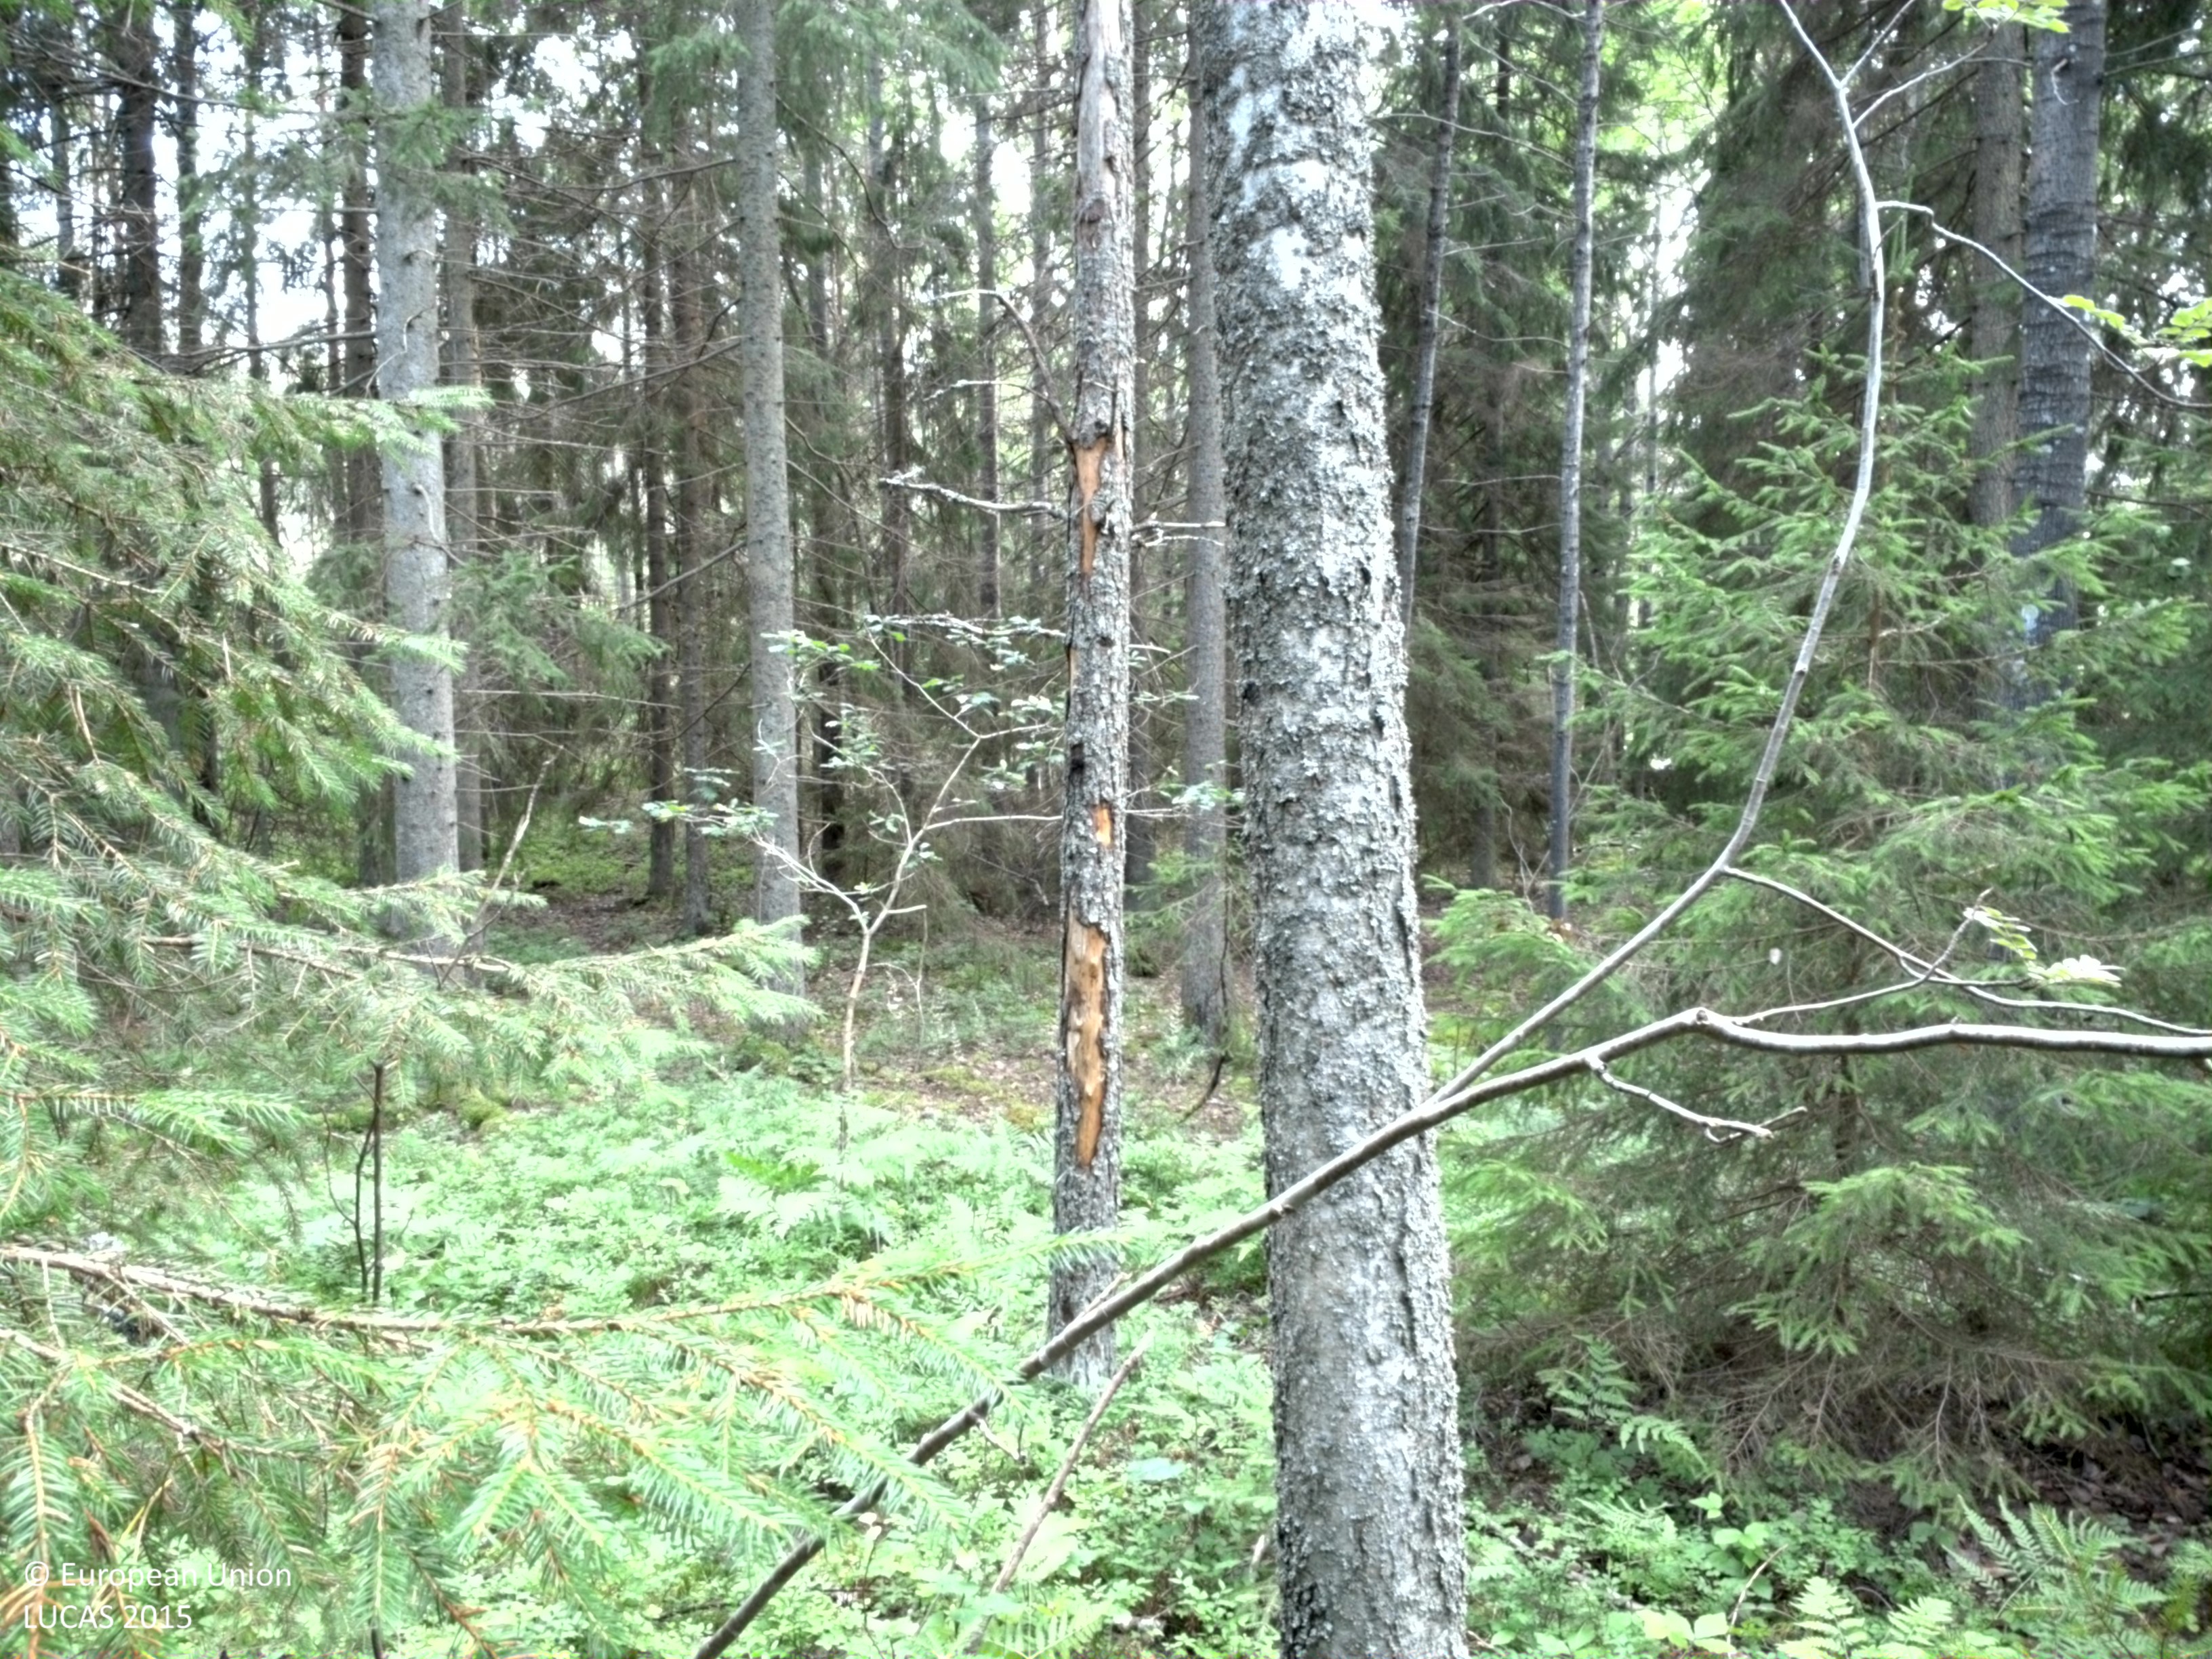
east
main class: Woodland
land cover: Spruce dominated coniferous woodland
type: boreal forest
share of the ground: > 75 %
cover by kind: coniferous forest trees 75 %, shrubs 10 %, lichens and mosses 10 %, broadleaved forest trees 5 %
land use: Forestry
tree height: > 5 m
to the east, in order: Spruce dominated coniferous woodland; Pine dominated coniferous woodland; Spruce dominated mixed woodland; Tracks; Spruce dominated mixed woodland; Pine dominated coniferous woodland; Spruce dominated mixed woodland; Pine dominated coniferous woodland; Spruce dominated mixed woodland
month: July
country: SE
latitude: 59.4852
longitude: 18.5640
